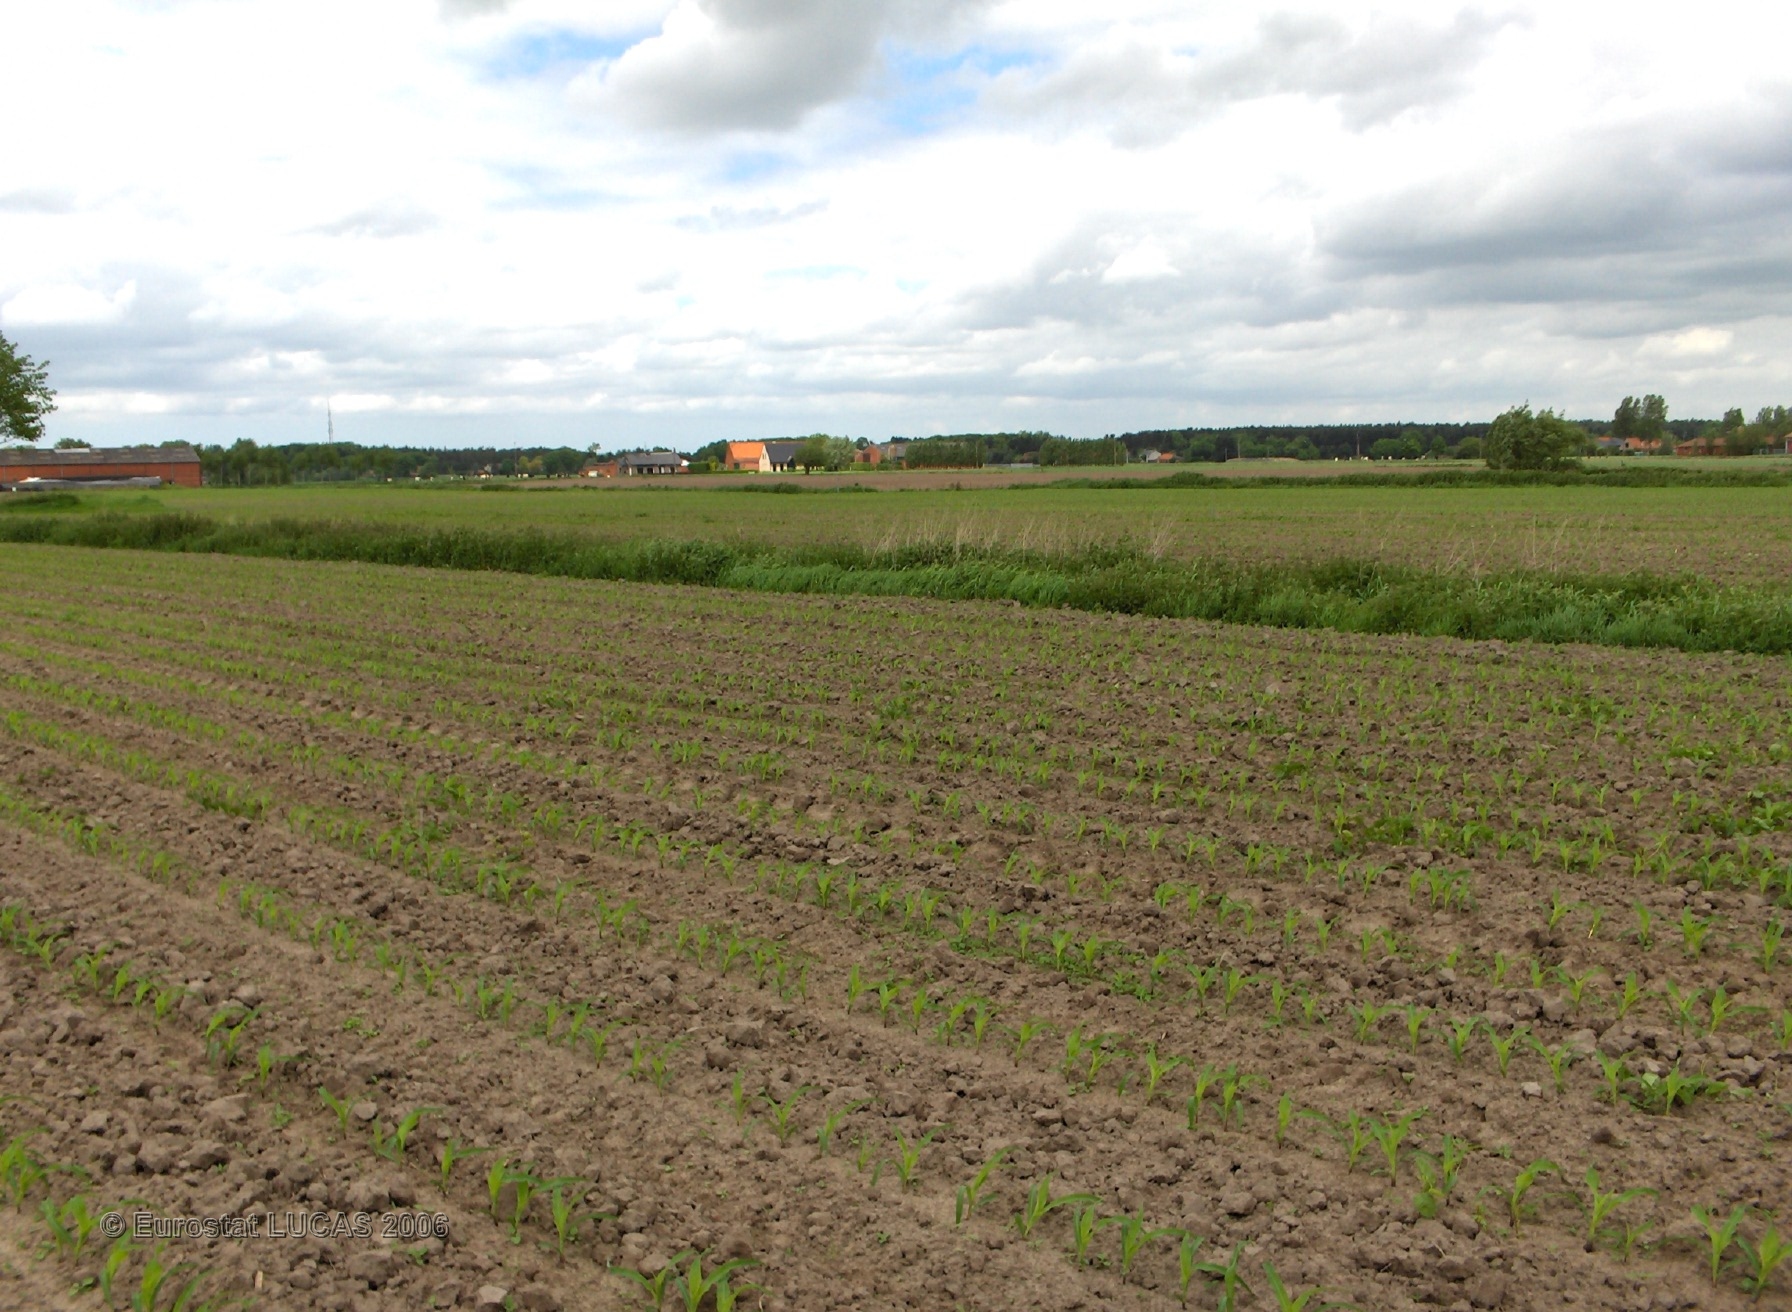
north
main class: Cropland
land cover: Maize
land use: Agriculture (excluding fallow land and kitchen gardens)
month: May
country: BE
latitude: 51.1620
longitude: 3.6581
